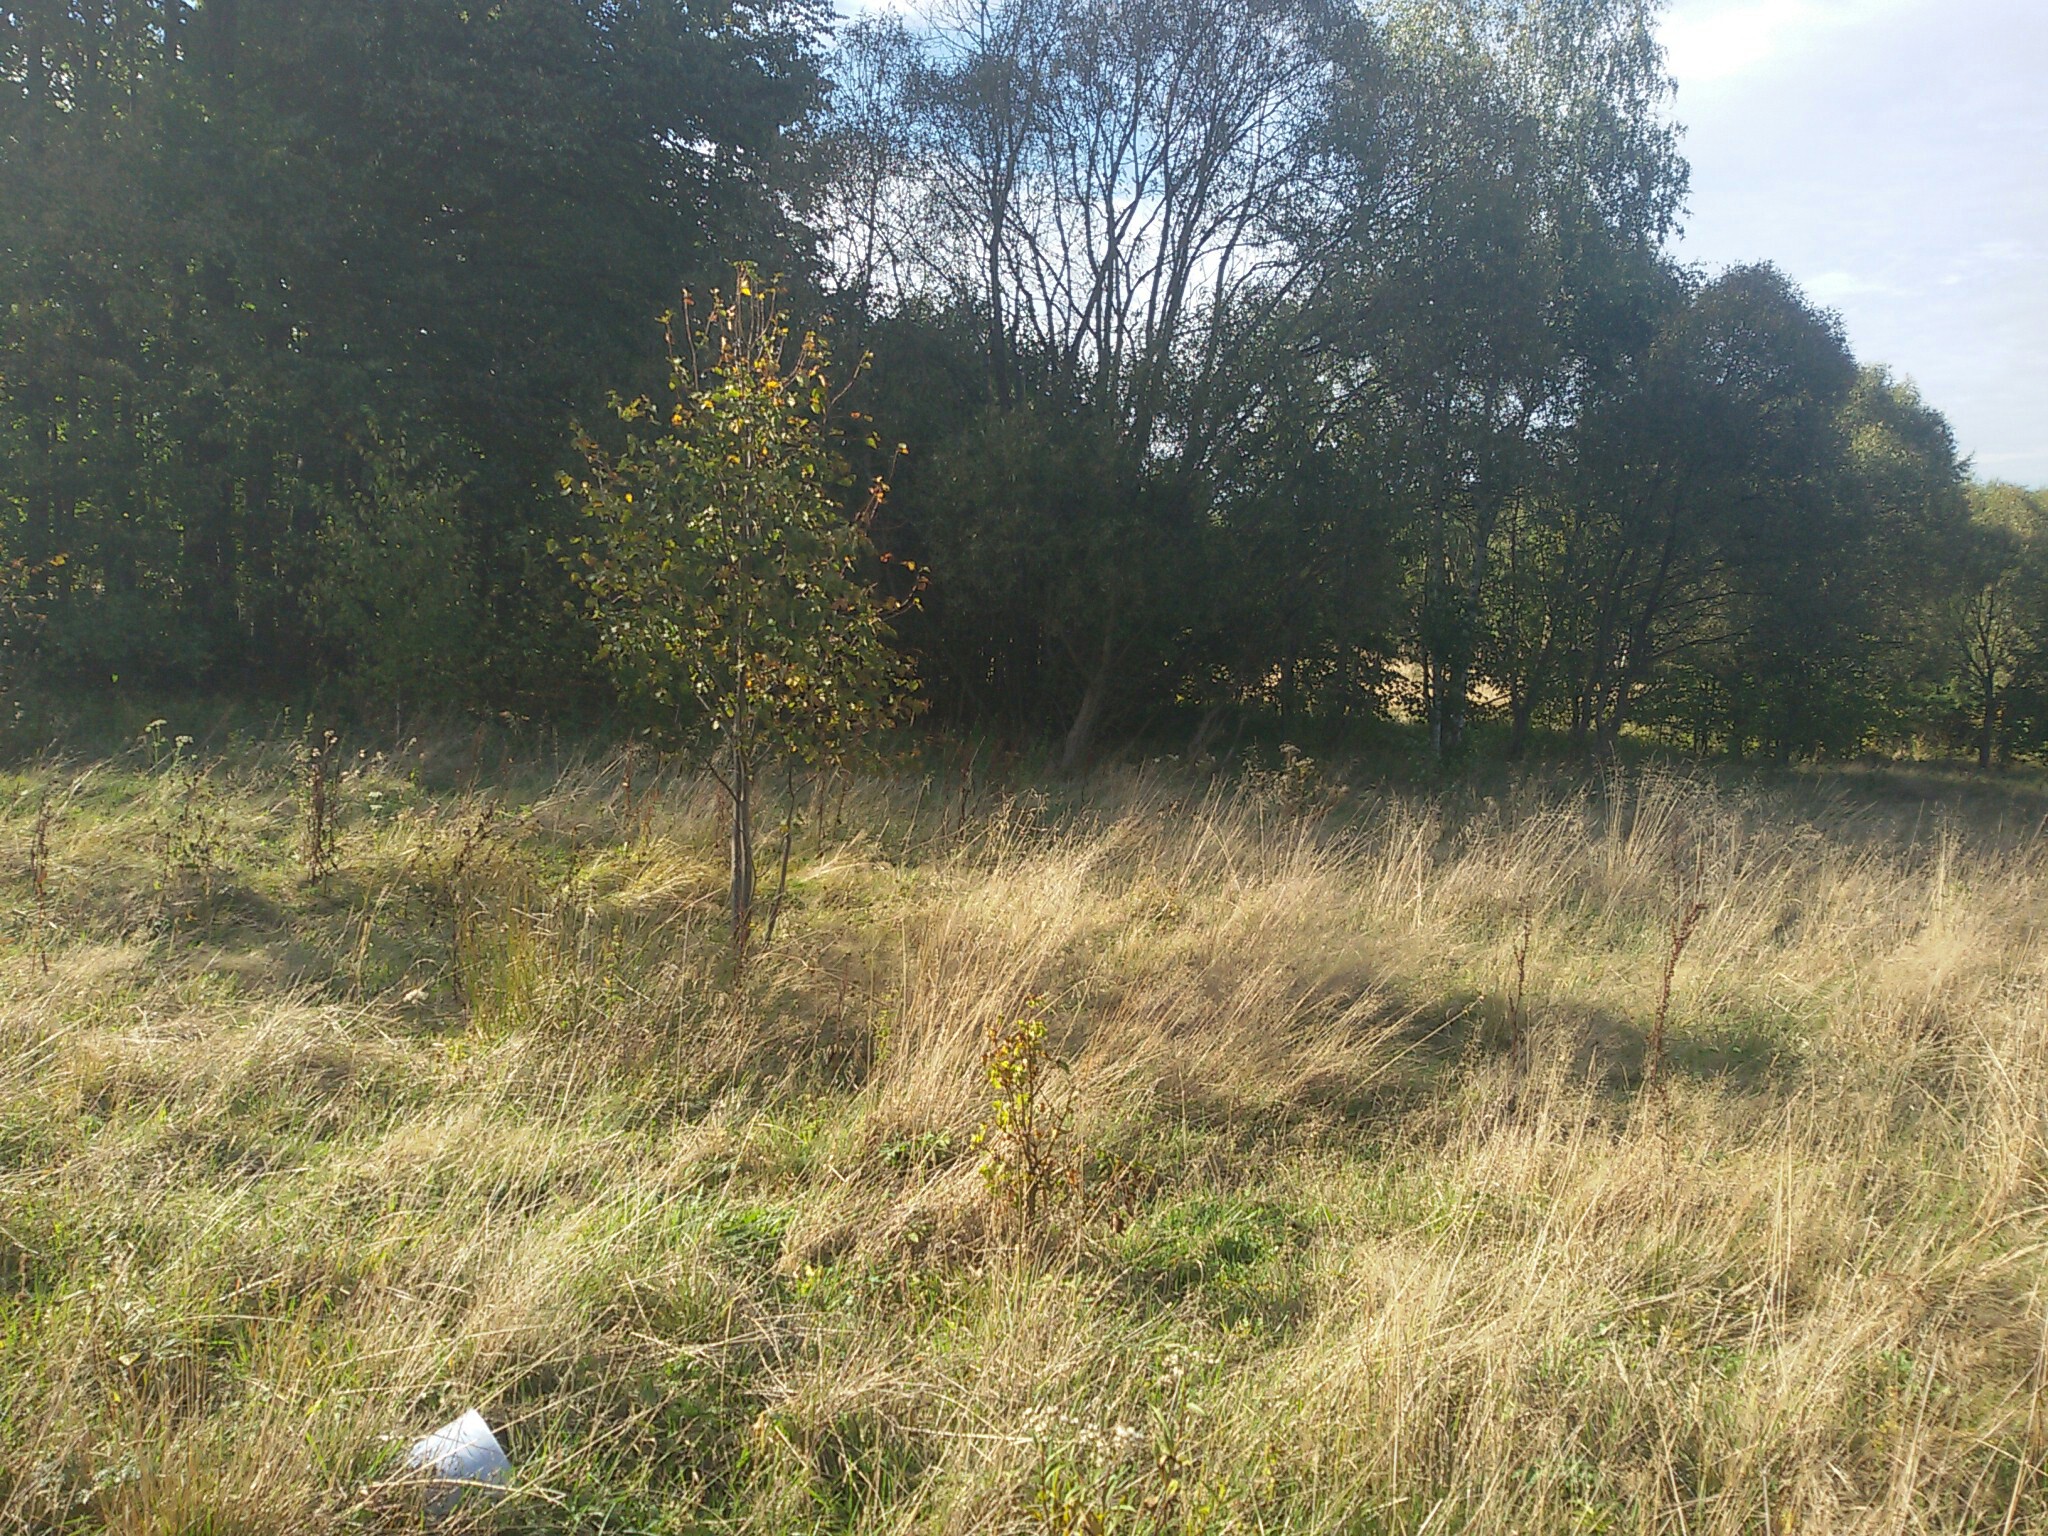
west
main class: Grassland
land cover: Grassland with sparse tree/shrub cover
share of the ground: > 75 %
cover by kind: herbaceous plants 95 %, broadleaved forest trees 5 %
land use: Semi-natural and natural areas not in use
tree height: < 5 m
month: September
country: PL
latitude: 50.9381
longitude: 15.4259
